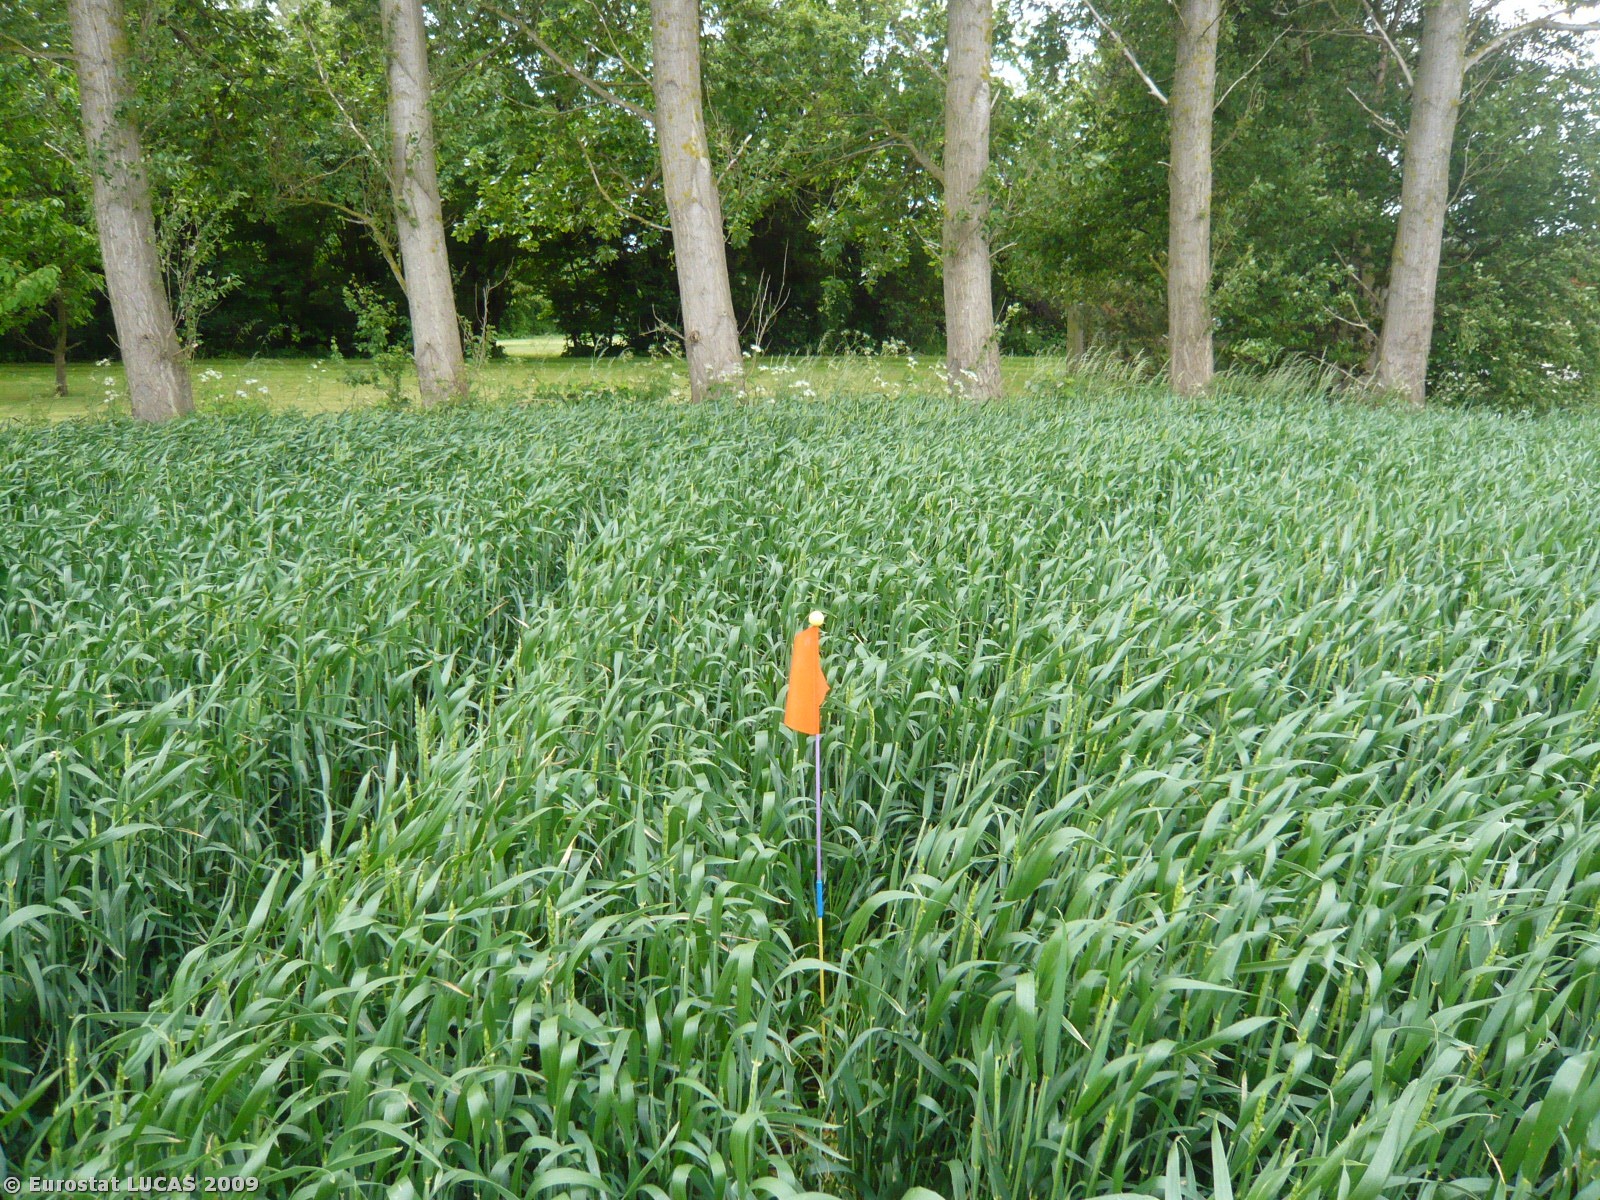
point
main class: Cropland
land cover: Common wheat
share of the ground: > 75 %
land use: Agriculture (excluding fallow land and kitchen gardens)
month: June
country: DK
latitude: 54.7168
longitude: 11.9393
